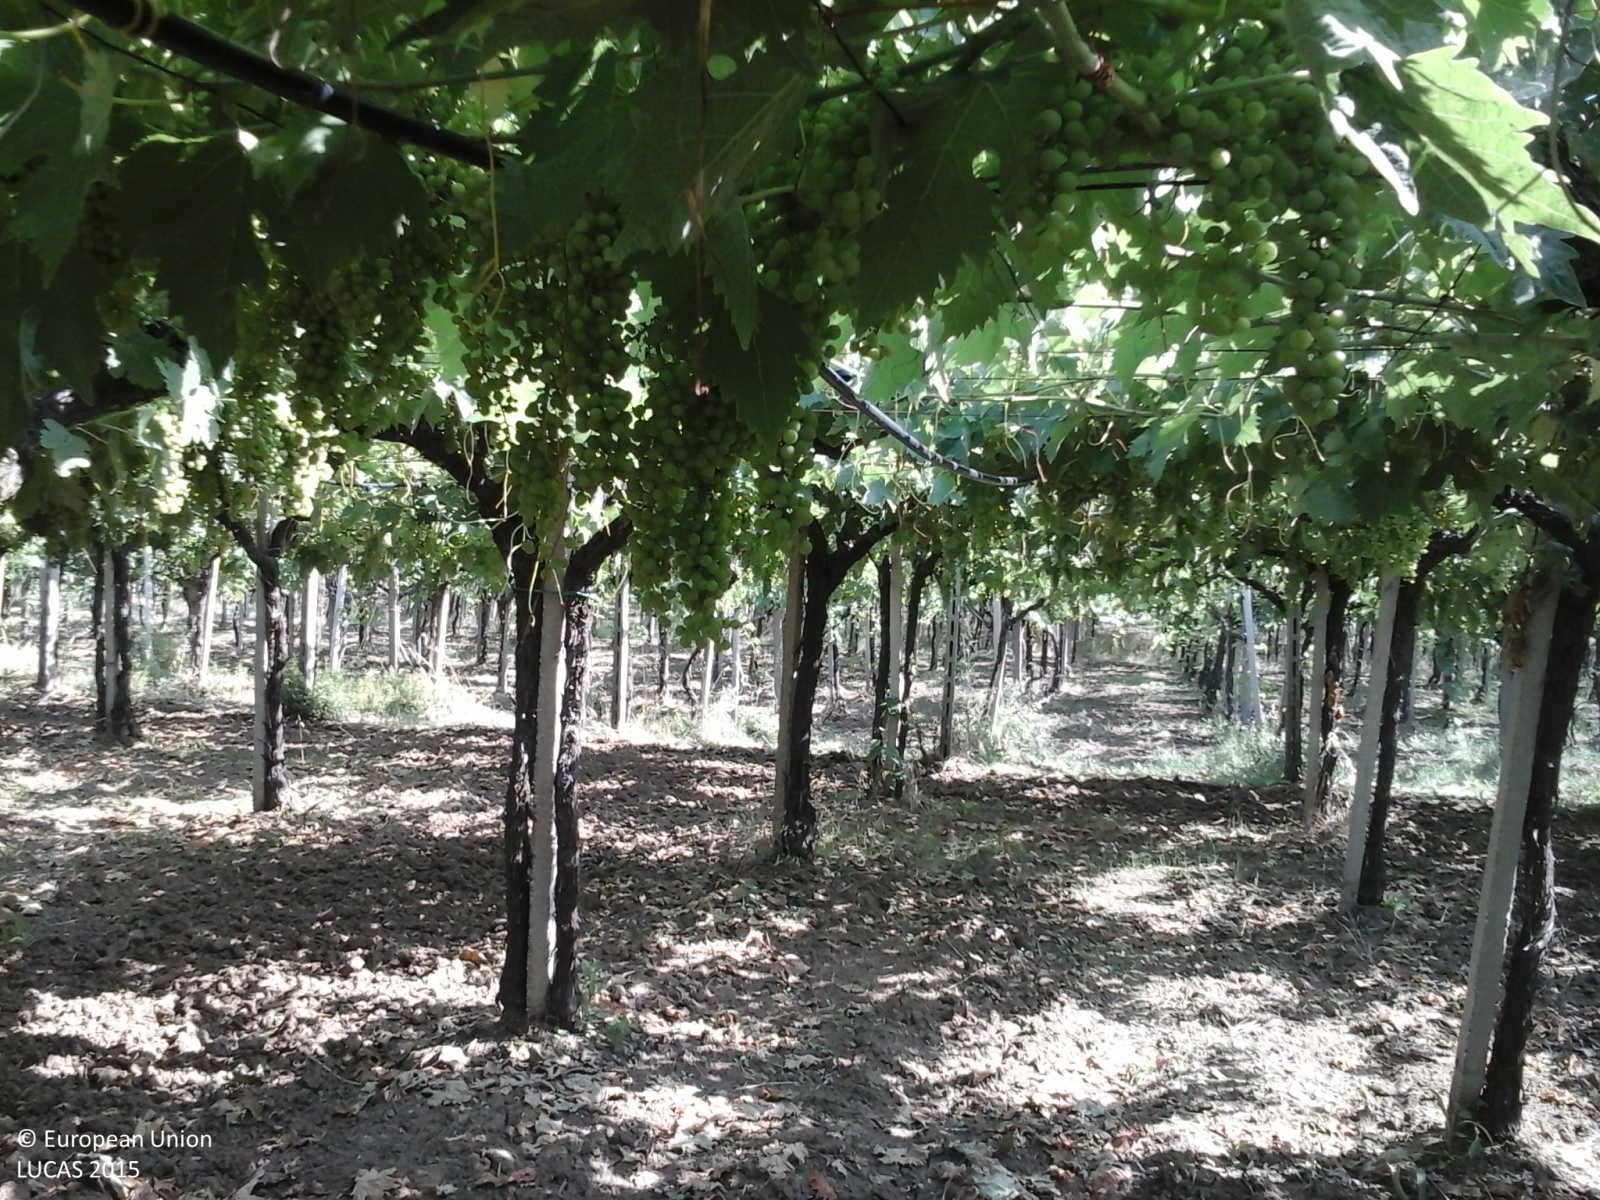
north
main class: Cropland
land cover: Vineyards
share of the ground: 25 - 50 %
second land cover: Spontaneously vegetated surfaces
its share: 25 - 50 %
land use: Agriculture (excluding fallow land and kitchen gardens)
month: July
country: IT
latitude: 42.3629
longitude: 14.3218
